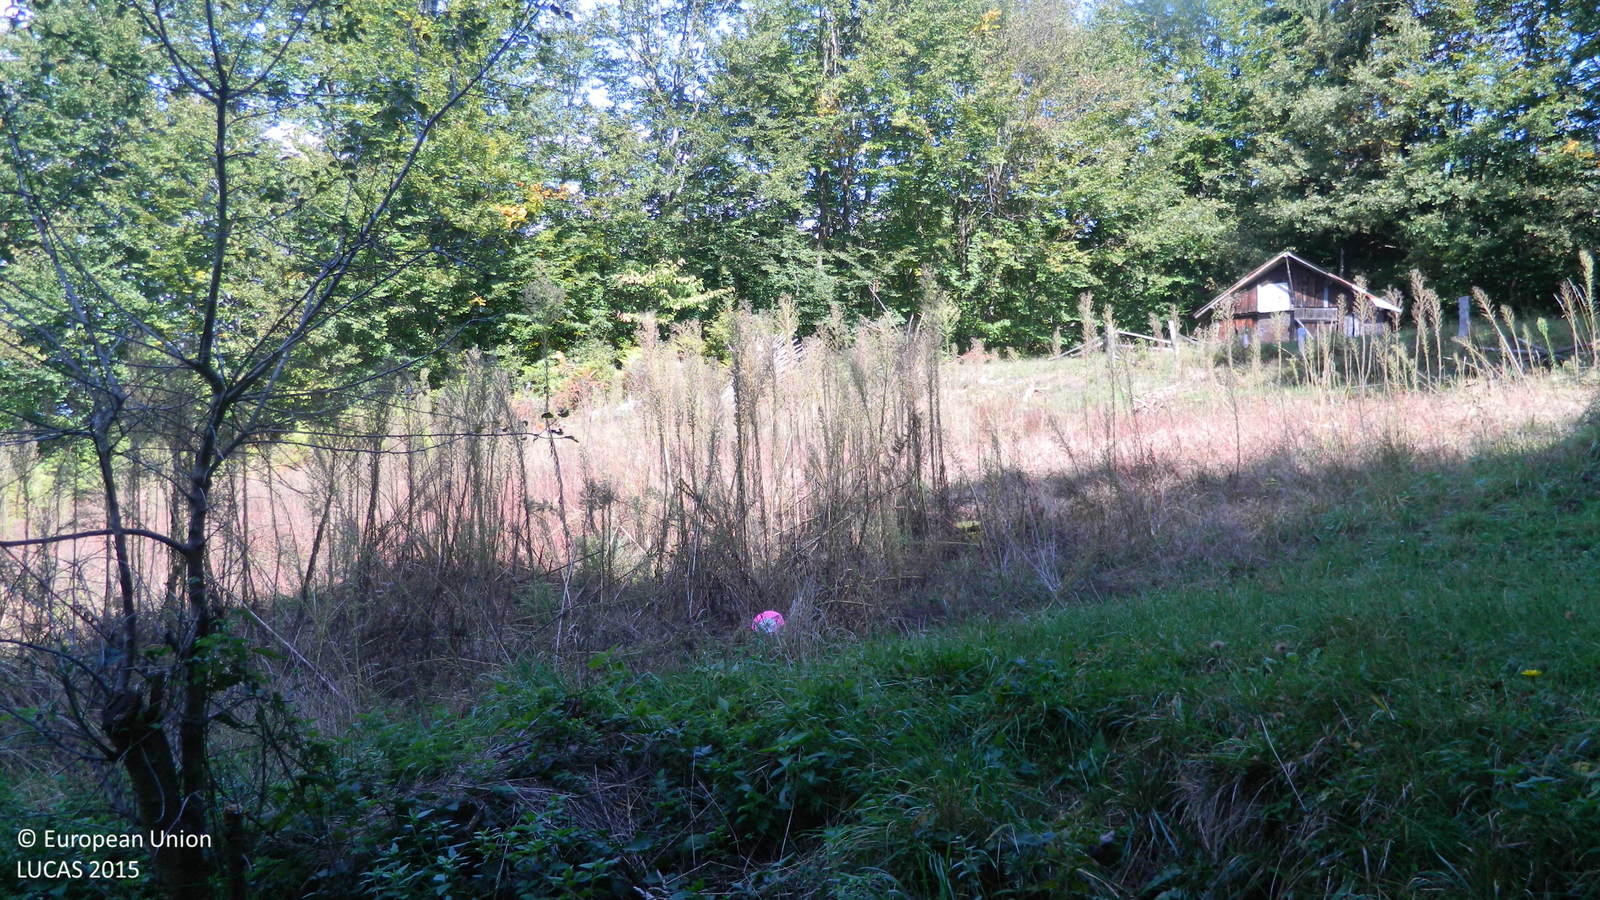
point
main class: Grassland
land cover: Spontaneously vegetated surfaces
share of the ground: > 75 %
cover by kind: herbaceous plants 100 %
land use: Agriculture (excluding fallow land and kitchen gardens)
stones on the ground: < 10 %
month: October
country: BG
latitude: 41.5094
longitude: 25.0130
